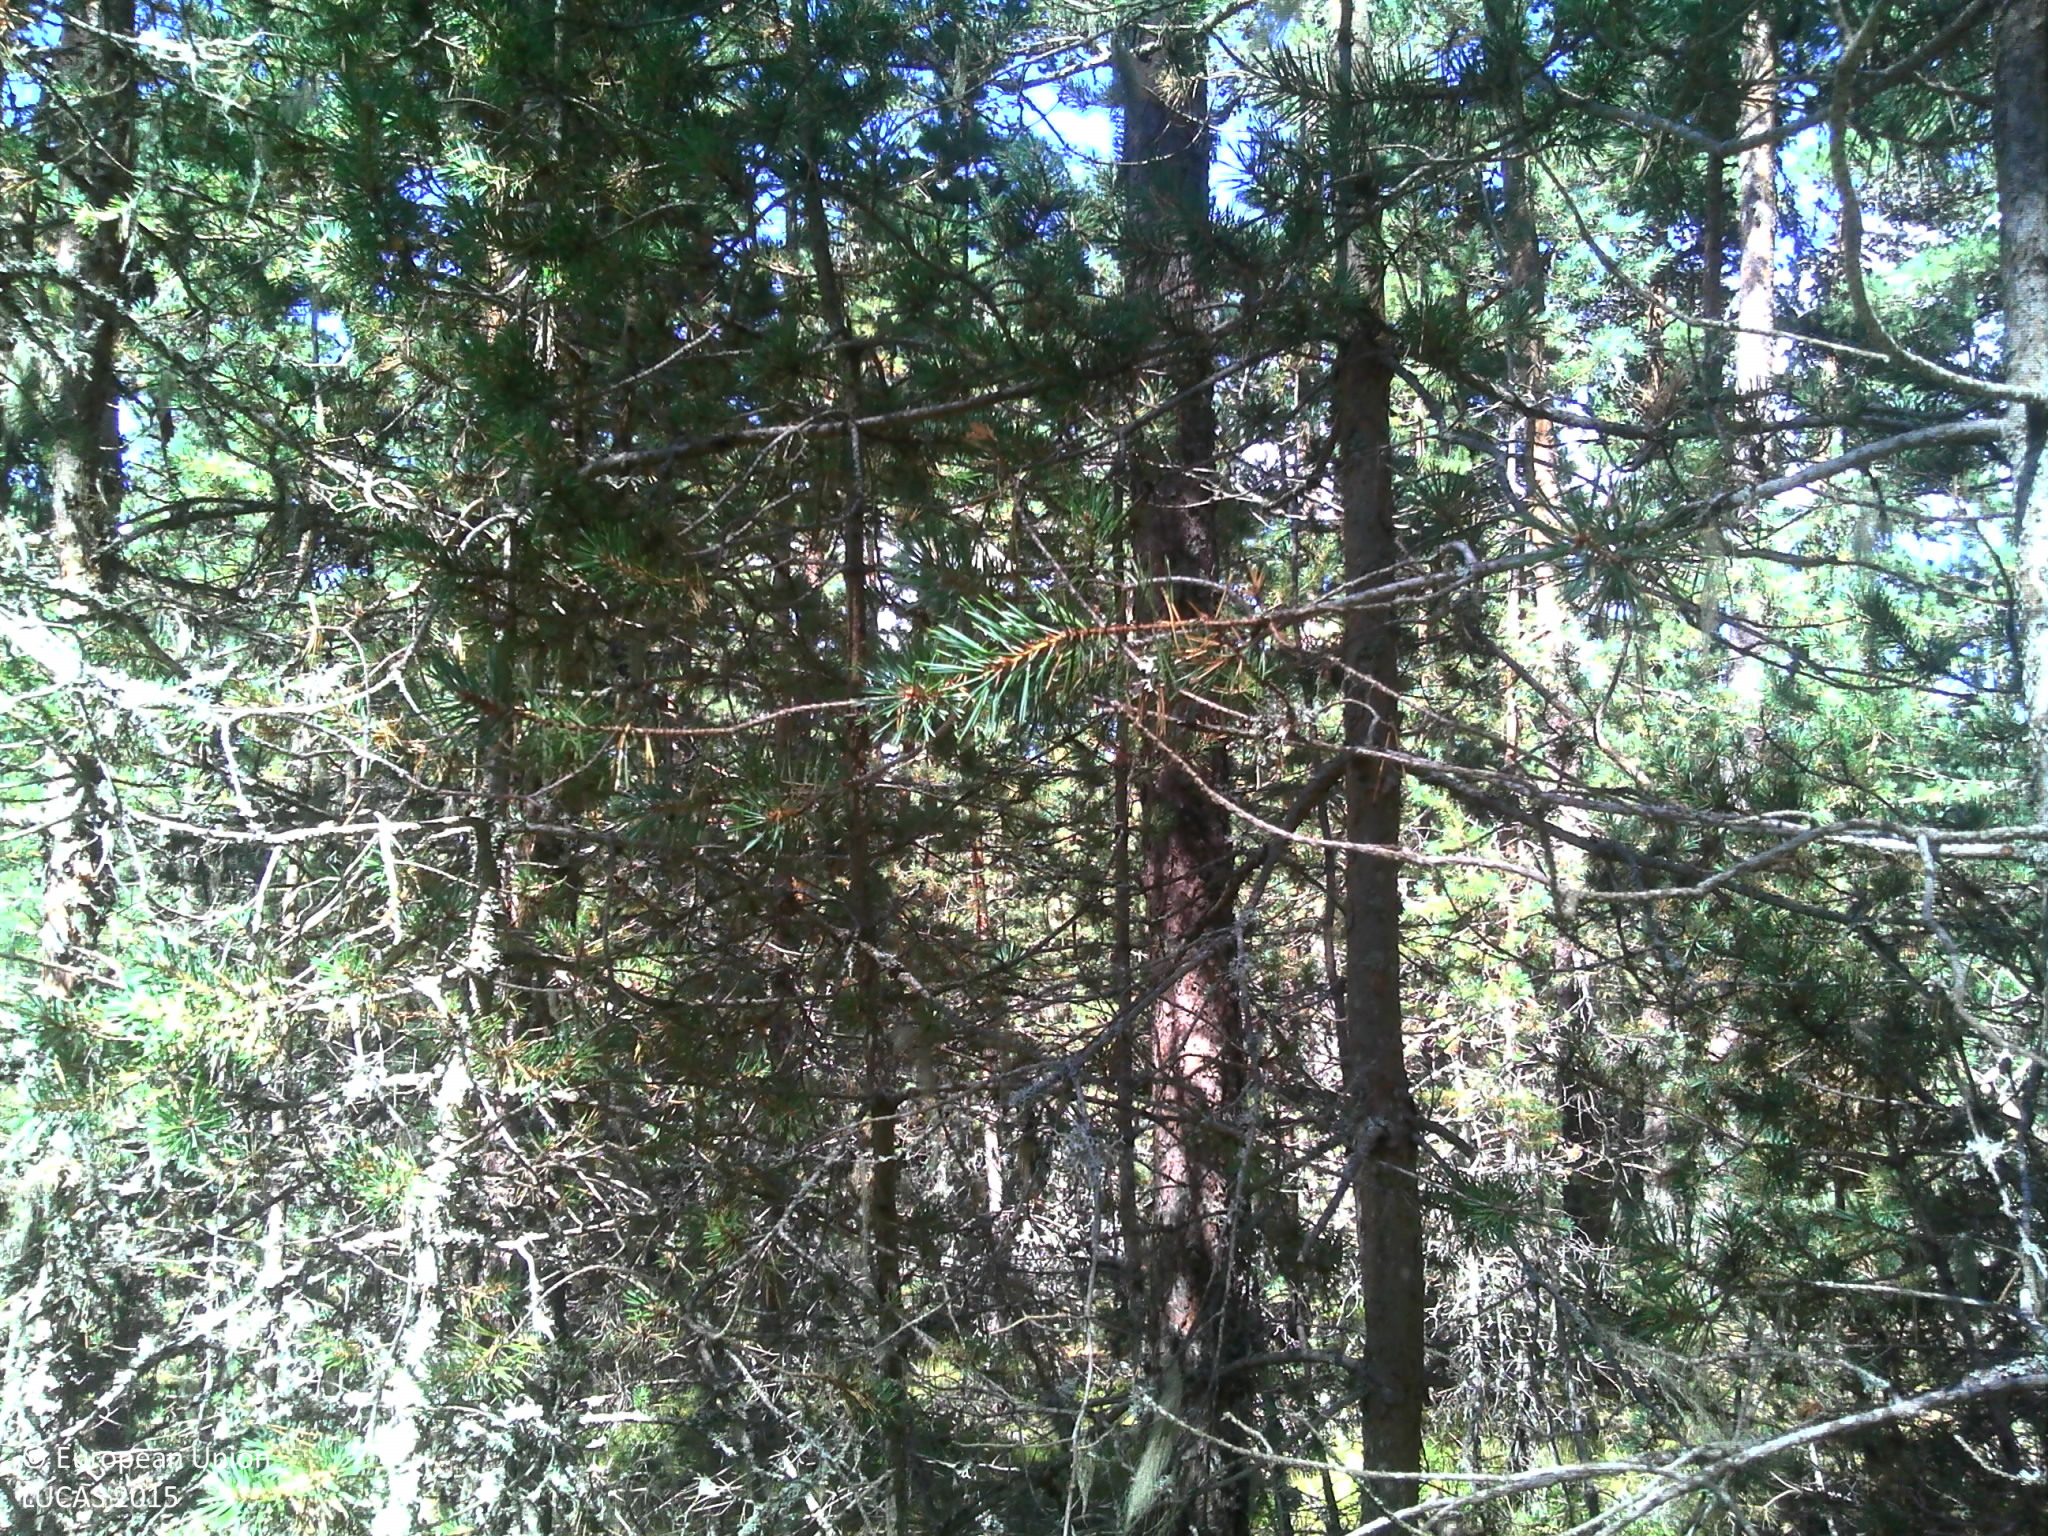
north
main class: Woodland
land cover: Pine dominated coniferous woodland
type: alpine coniferous forest
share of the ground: > 75 %
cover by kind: coniferous forest trees 75 %, herbaceous plants 20 %, broadleaved forest trees 5 %
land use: Forestry
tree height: > 5 m
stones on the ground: > 50 %
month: August
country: FR
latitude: 44.5835
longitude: 3.5438
